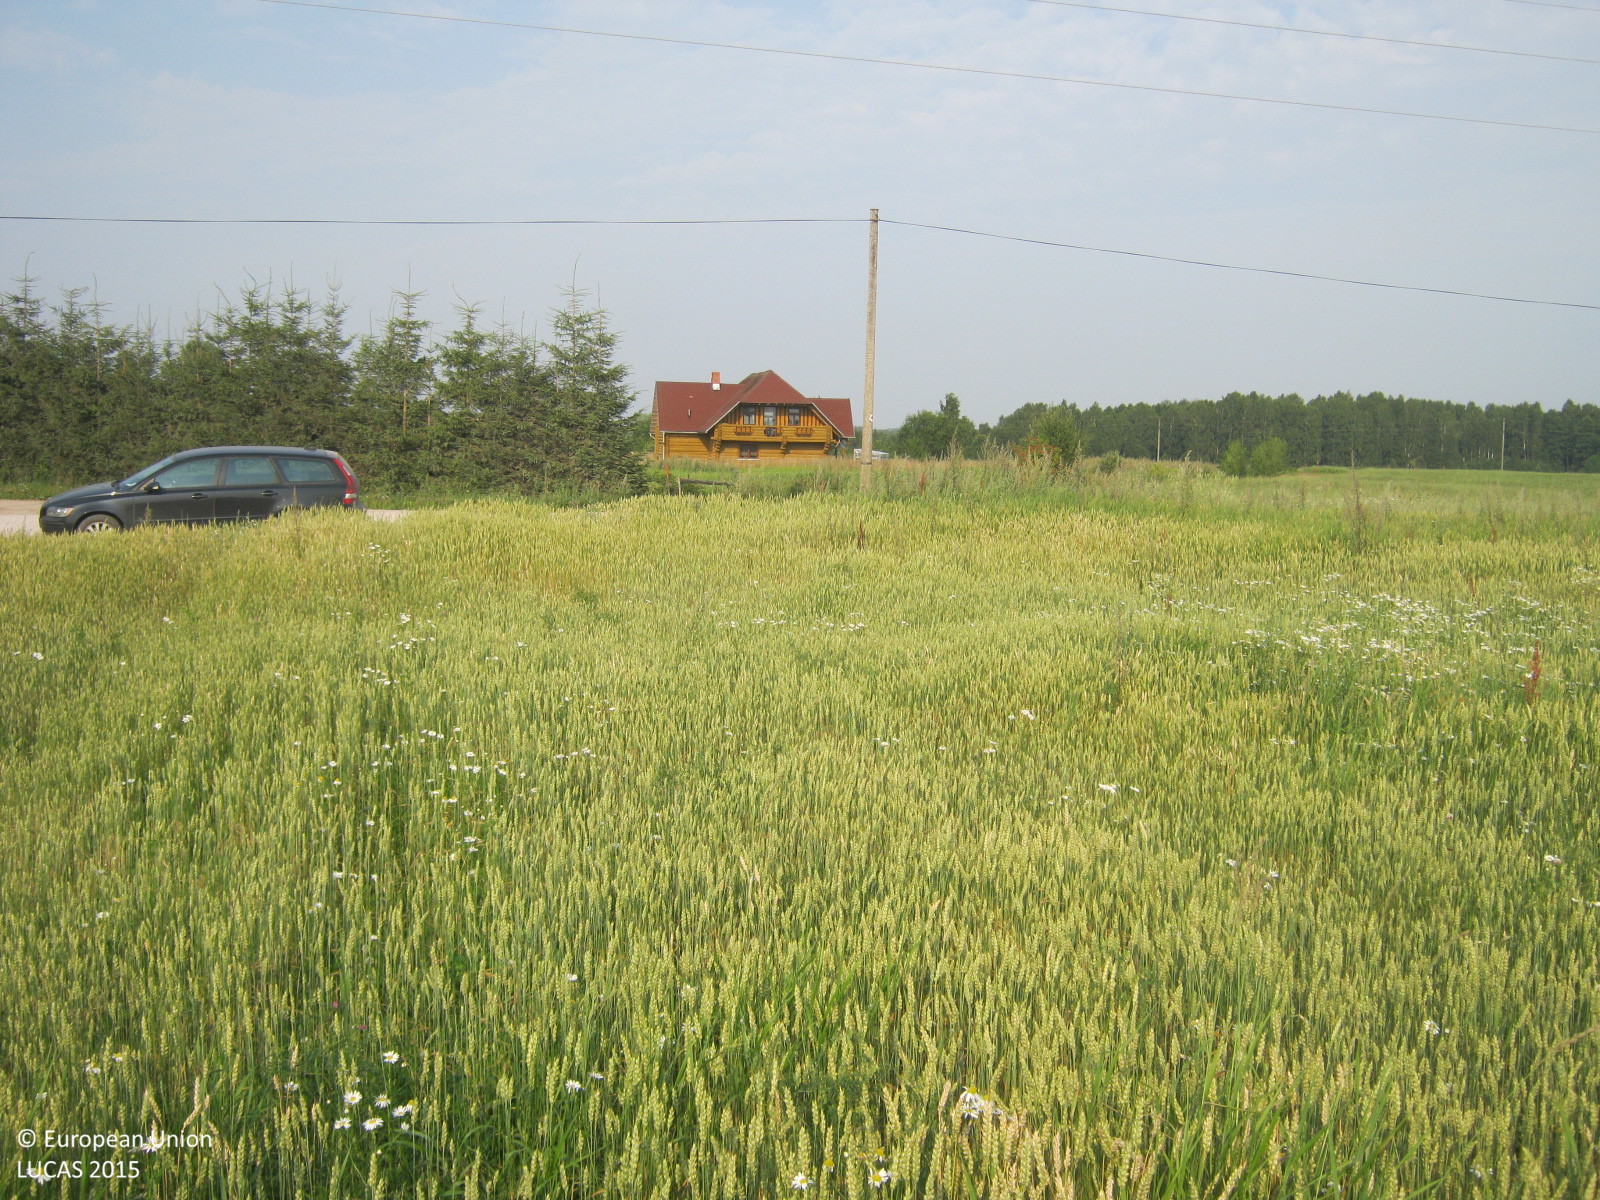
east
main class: Cropland
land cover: Common wheat
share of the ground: > 75 %
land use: Agriculture (excluding fallow land and kitchen gardens)
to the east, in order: Common wheat; Electric lines; Grass margins; Paved roads, cycling and walking lanes; Grass margins; Electric lines; Grassland without tree/shrub cover; Clovers
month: August
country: LV
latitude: 57.4267
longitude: 24.6673
